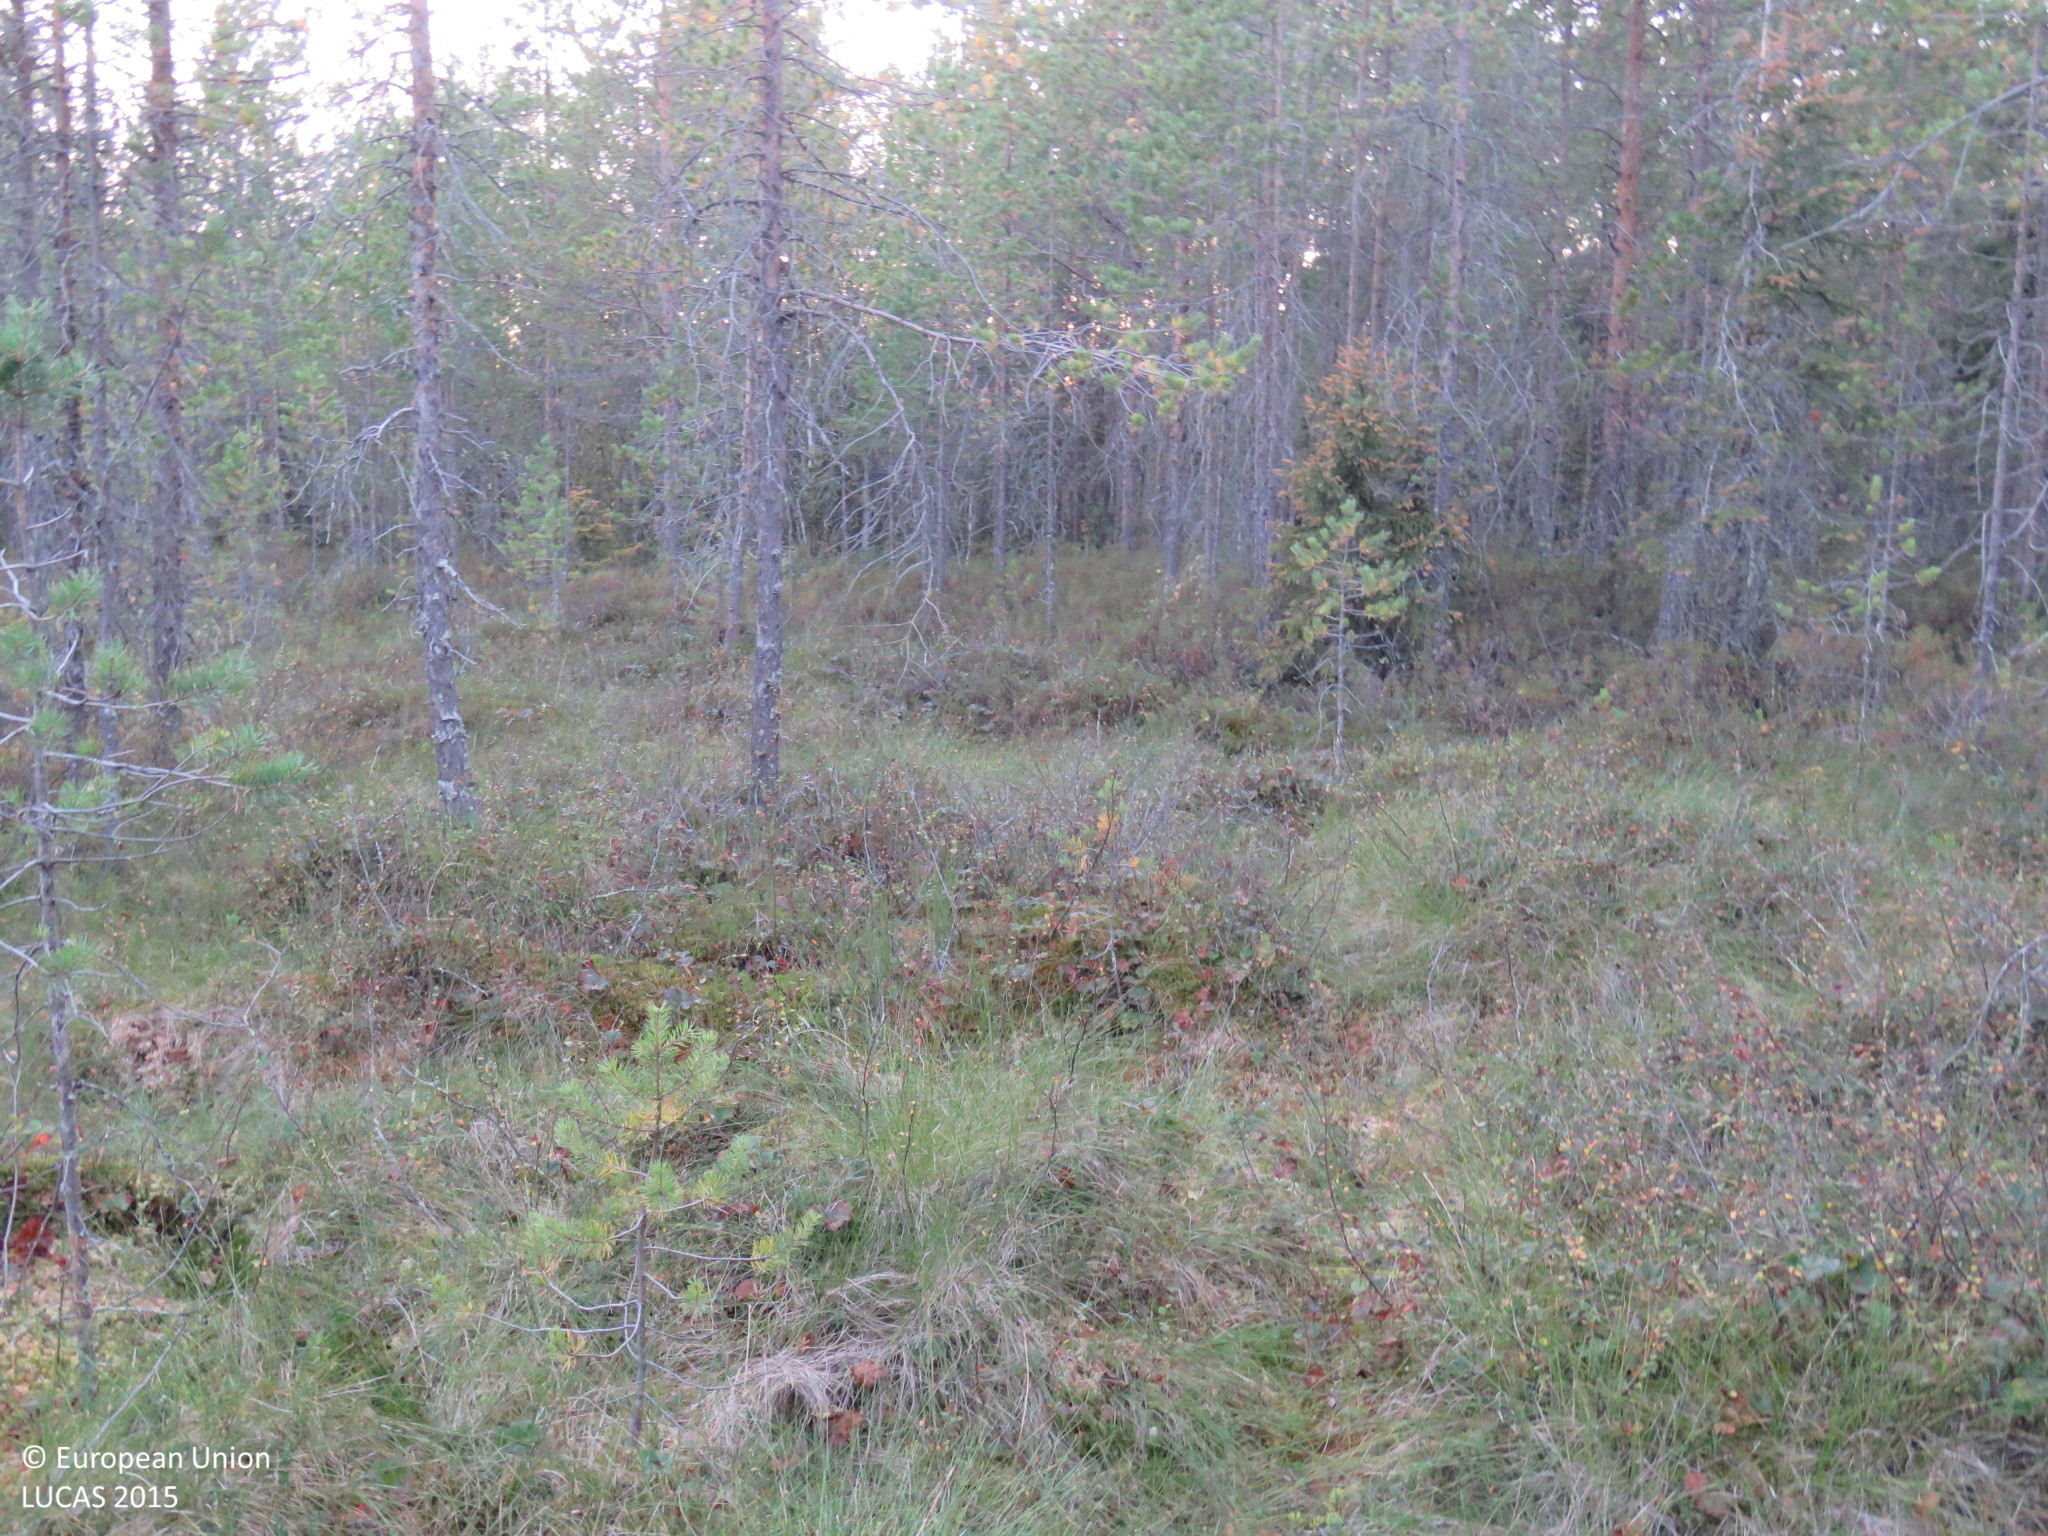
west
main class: Woodland
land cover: Pine dominated coniferous woodland
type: mire and swamp forests
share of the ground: 50 - 75 %
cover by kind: coniferous forest trees 50 %, herbaceous plants 20 %, broadleaved forest trees 15 %, shrubs 10 %, lichens and mosses 5 %
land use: Forestry
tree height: > 5 m
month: August
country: FI
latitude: 64.9970
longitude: 25.8901
